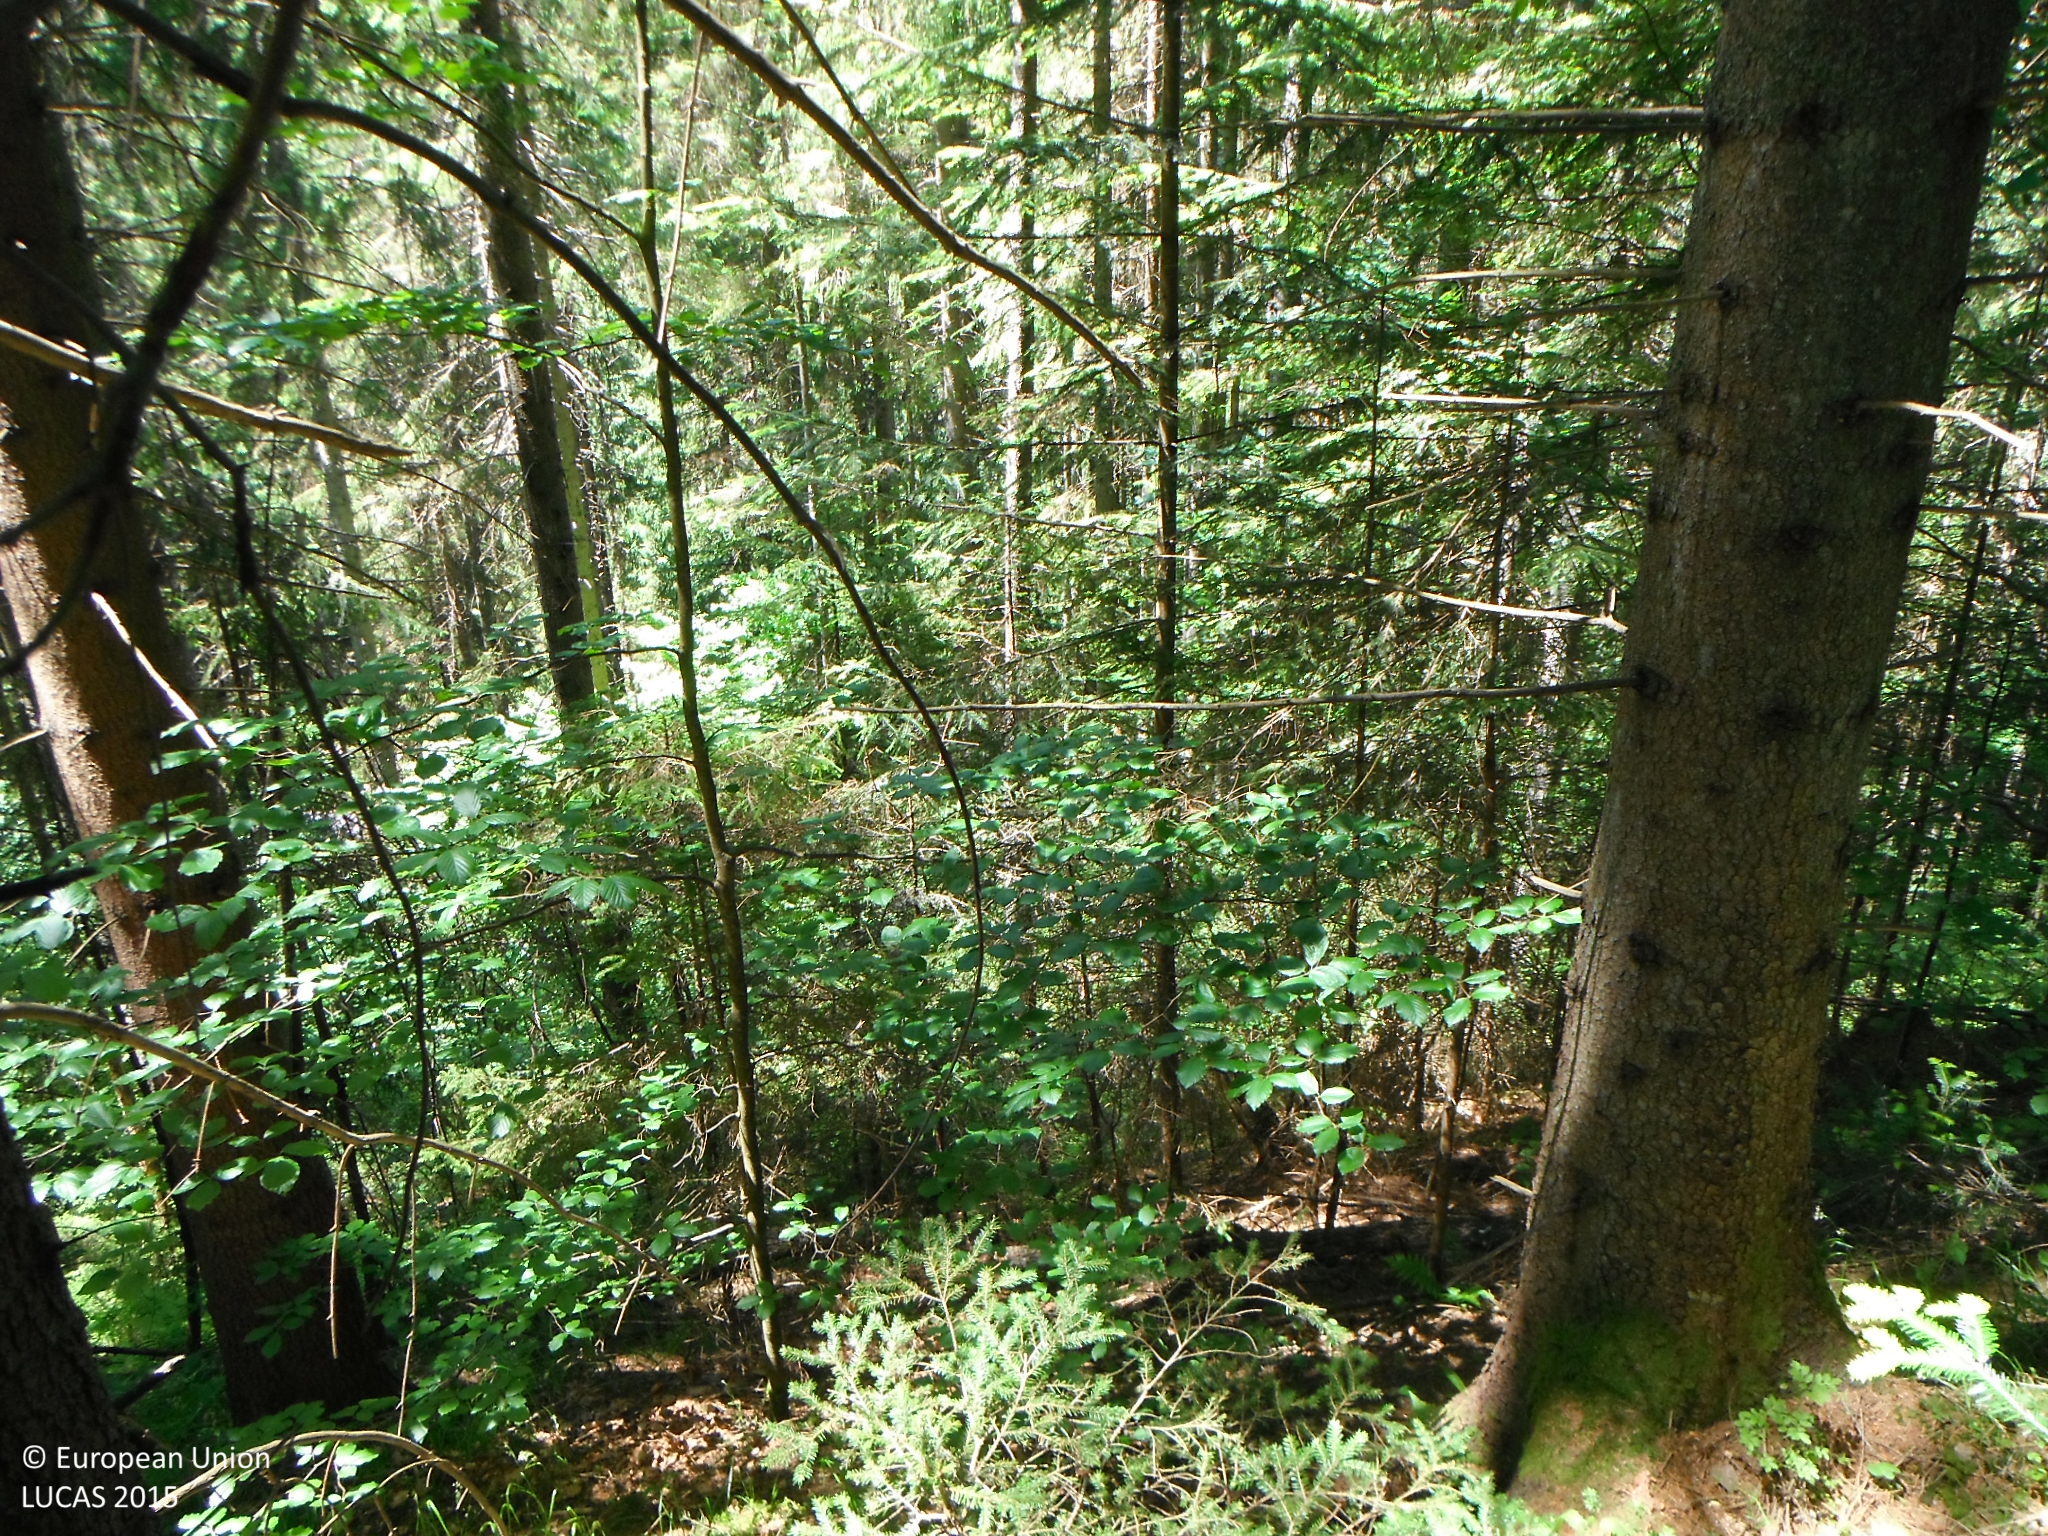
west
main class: Woodland
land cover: Spruce dominated coniferous woodland
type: alpine coniferous forest
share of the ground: > 75 %
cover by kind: coniferous forest trees 100 %
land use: Forestry
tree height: > 5 m
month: June
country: SK
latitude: 48.7244
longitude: 19.6375
